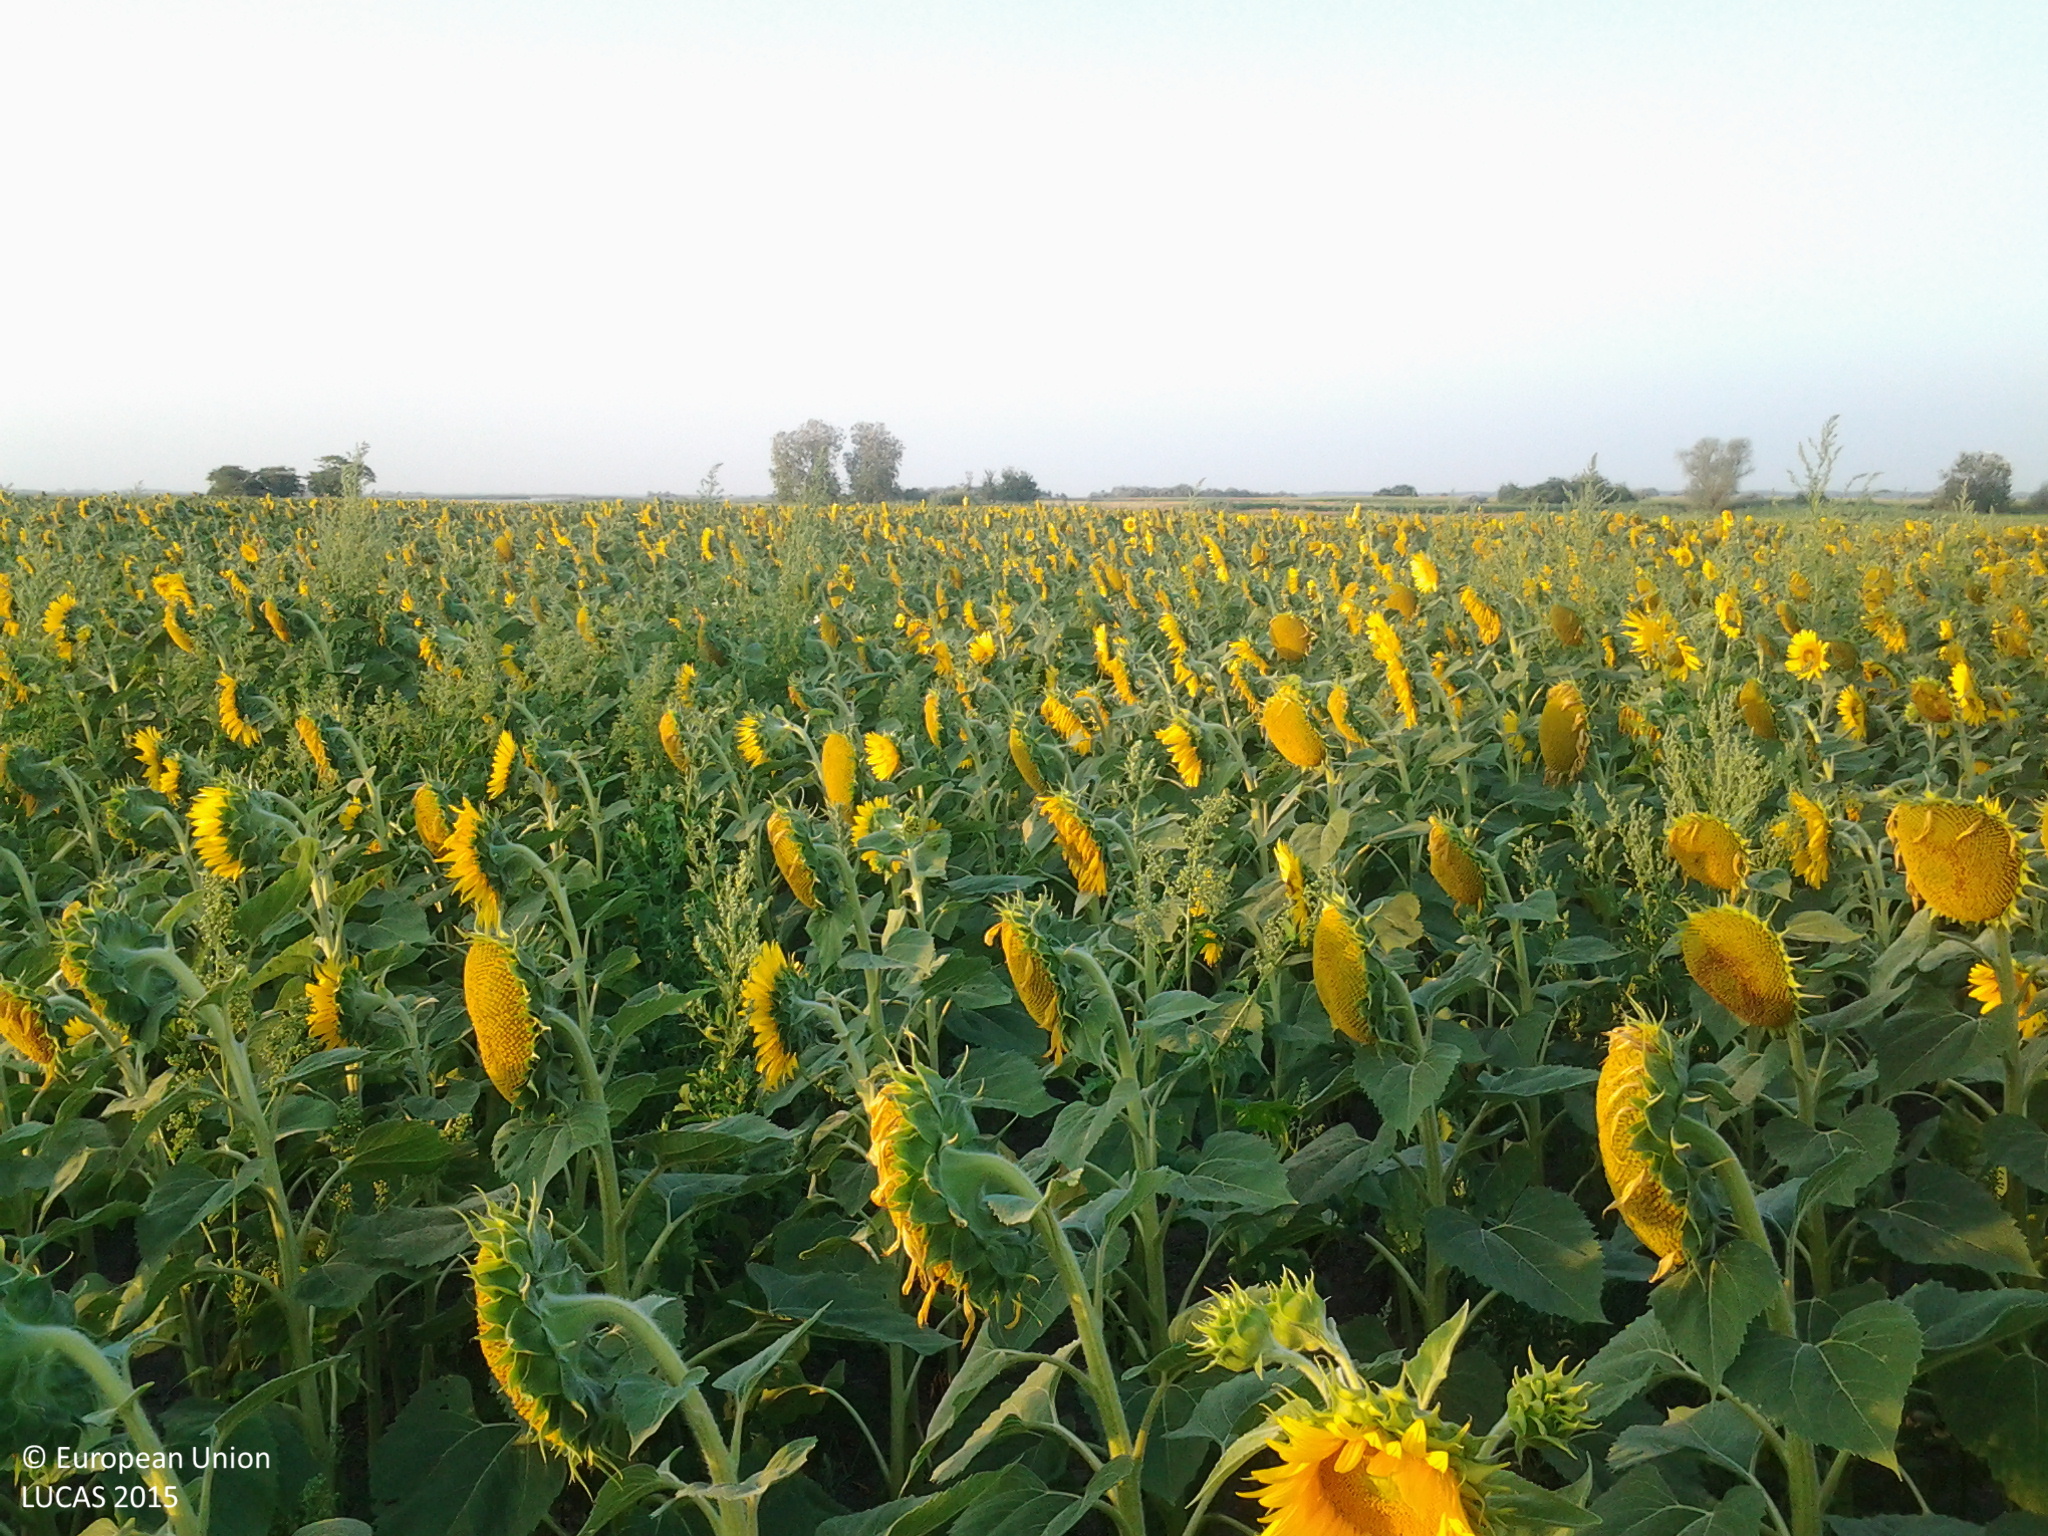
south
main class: Cropland
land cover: Sunflower
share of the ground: > 75 %
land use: Agriculture (excluding fallow land and kitchen gardens)
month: July
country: HU
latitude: 46.8813
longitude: 19.1625
